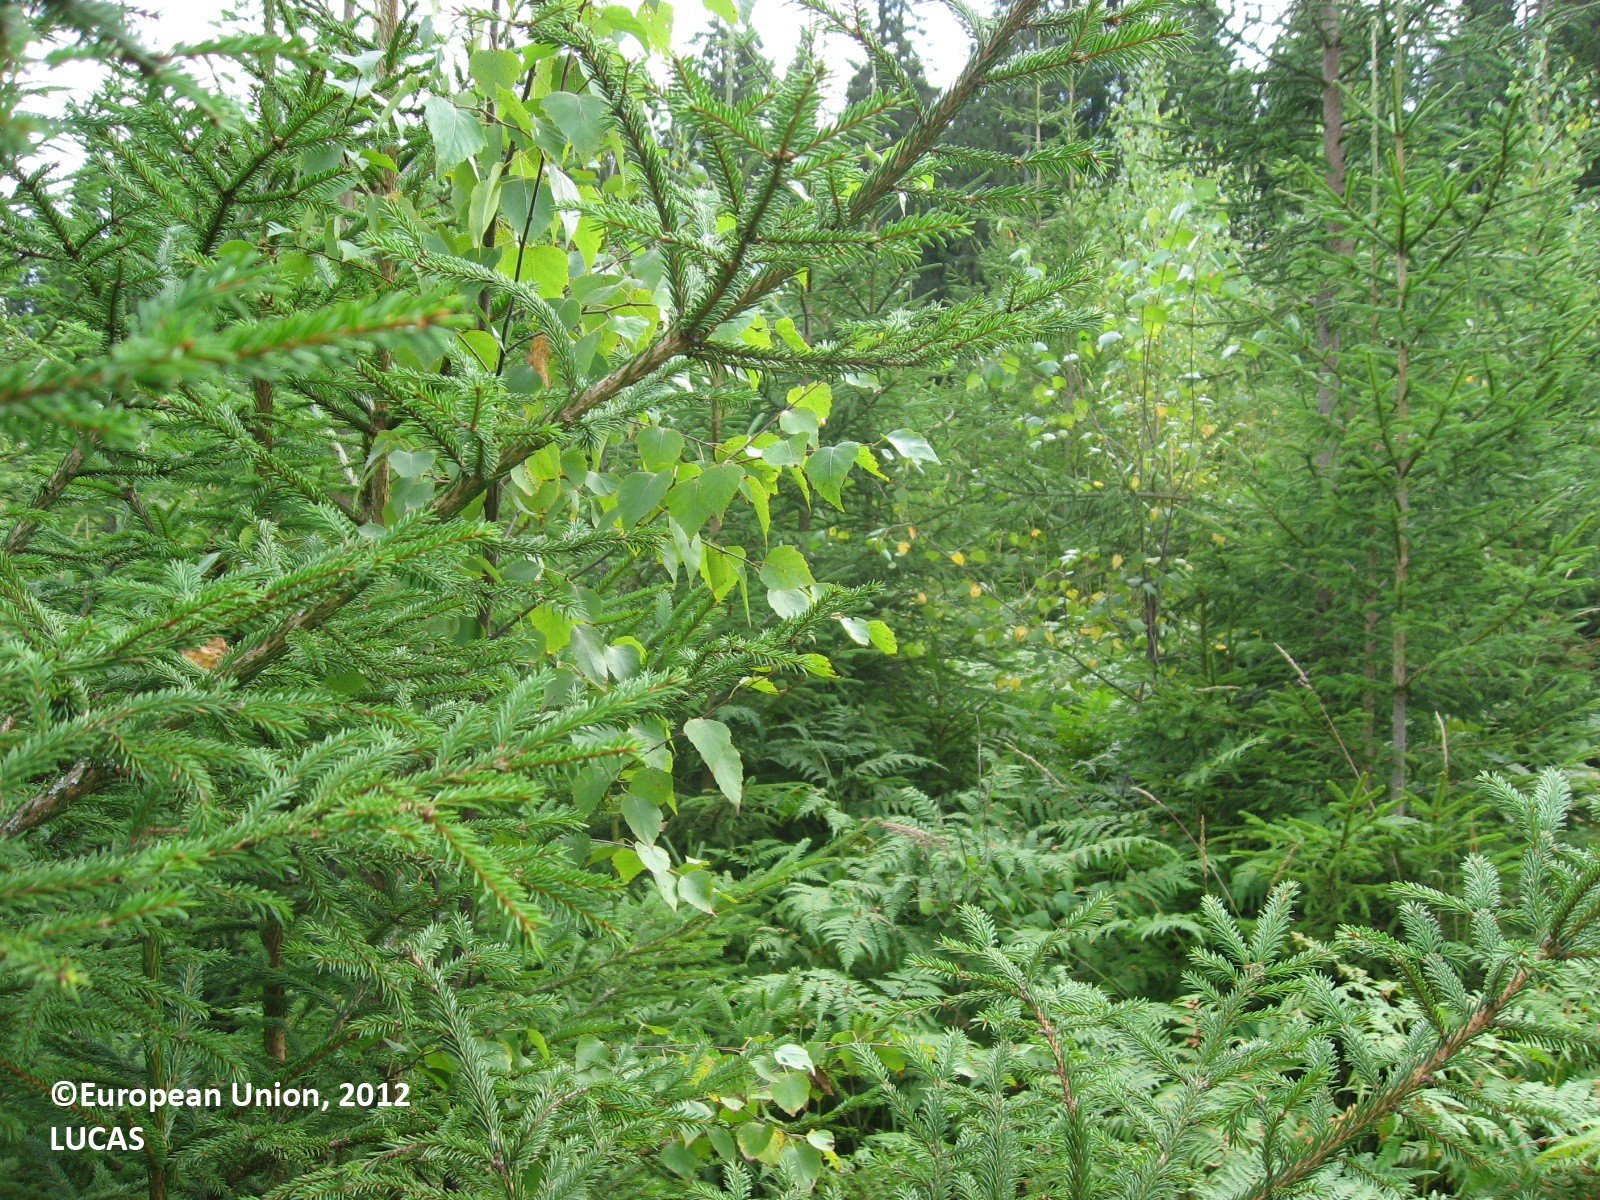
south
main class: Woodland
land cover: Spruce dominated mixed woodland
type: boreal forest
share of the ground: > 75 %
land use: Forestry
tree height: < 5 m
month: August
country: FI
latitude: 61.2271
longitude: 24.8396
